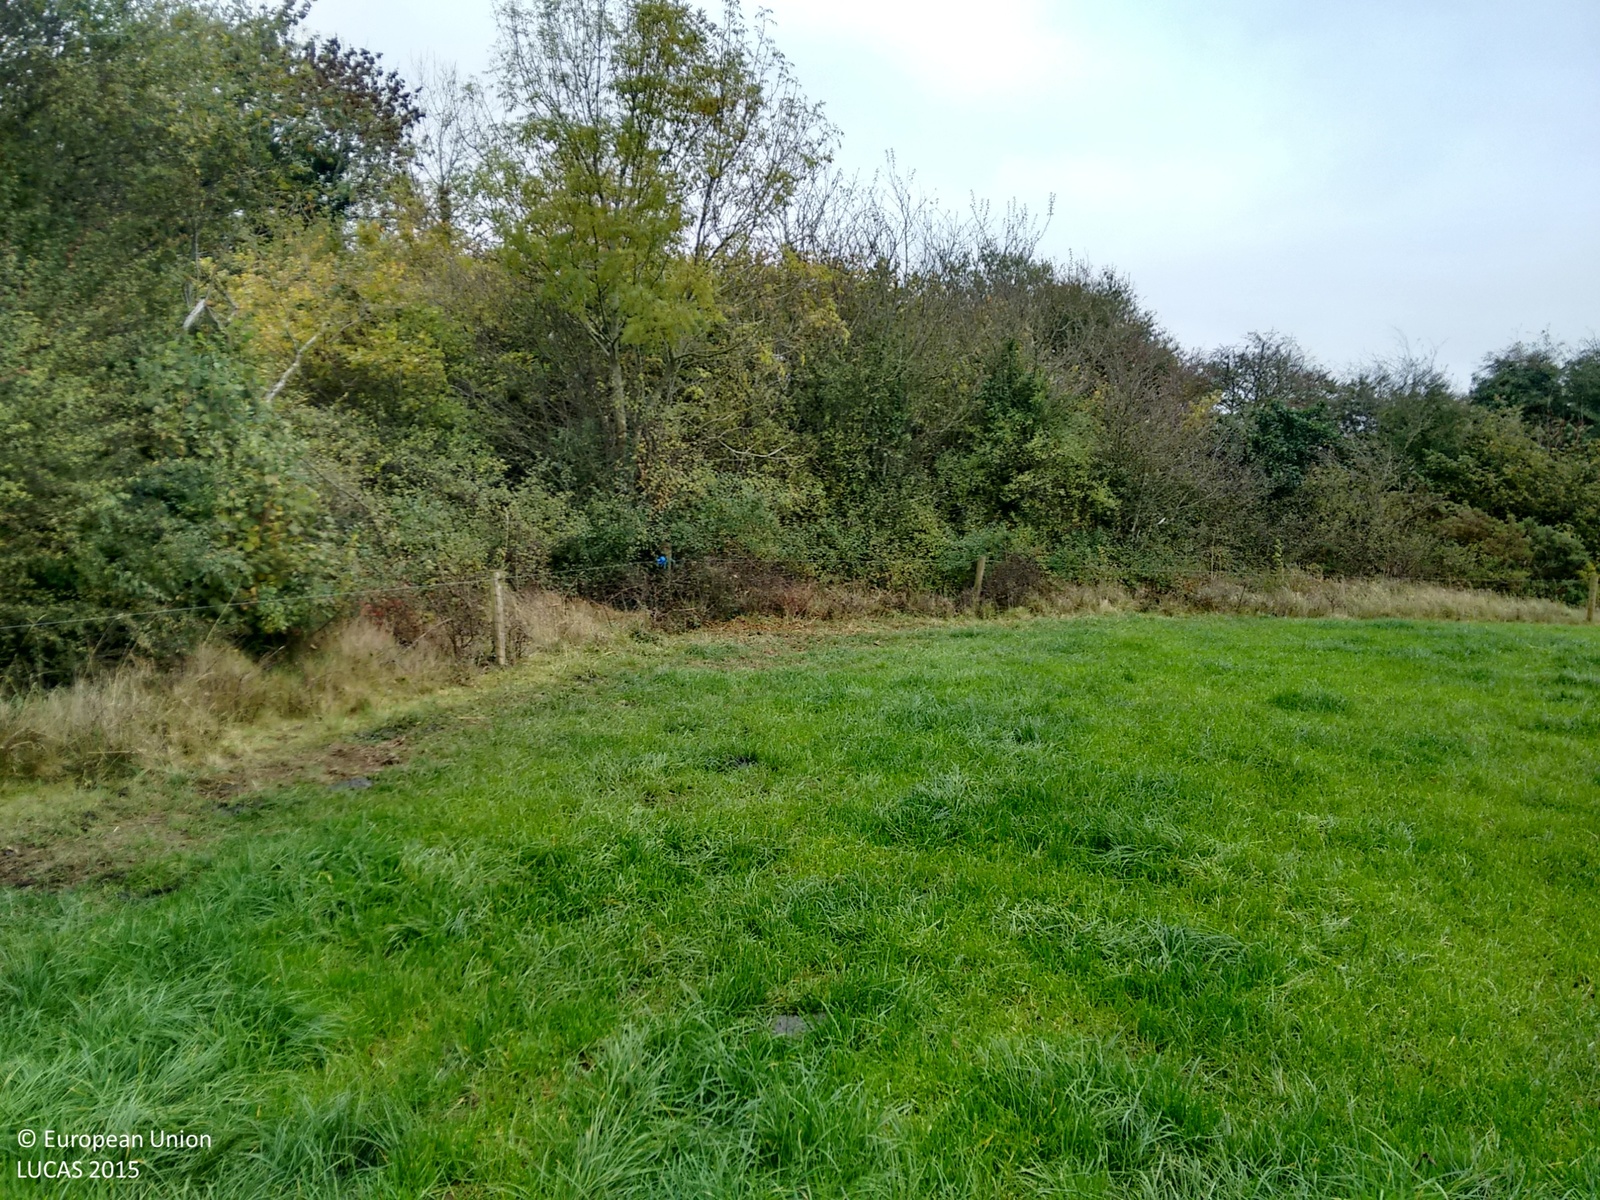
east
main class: Grassland
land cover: Grassland without tree/shrub cover
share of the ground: > 75 %
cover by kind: herbaceous plants 95 %, unconsolidated bare surface 5 %
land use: Agriculture (excluding fallow land and kitchen gardens)
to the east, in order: Grassland without tree/shrub cover; Fences; Broadleaved woodland; Rivers and streams; Broadleaved woodland; Fences; Grassland without tree/shrub cover; Abandoned hedges; Grassland without tree/shrub cover
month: October
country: IE
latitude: 52.7344
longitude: -7.7770
